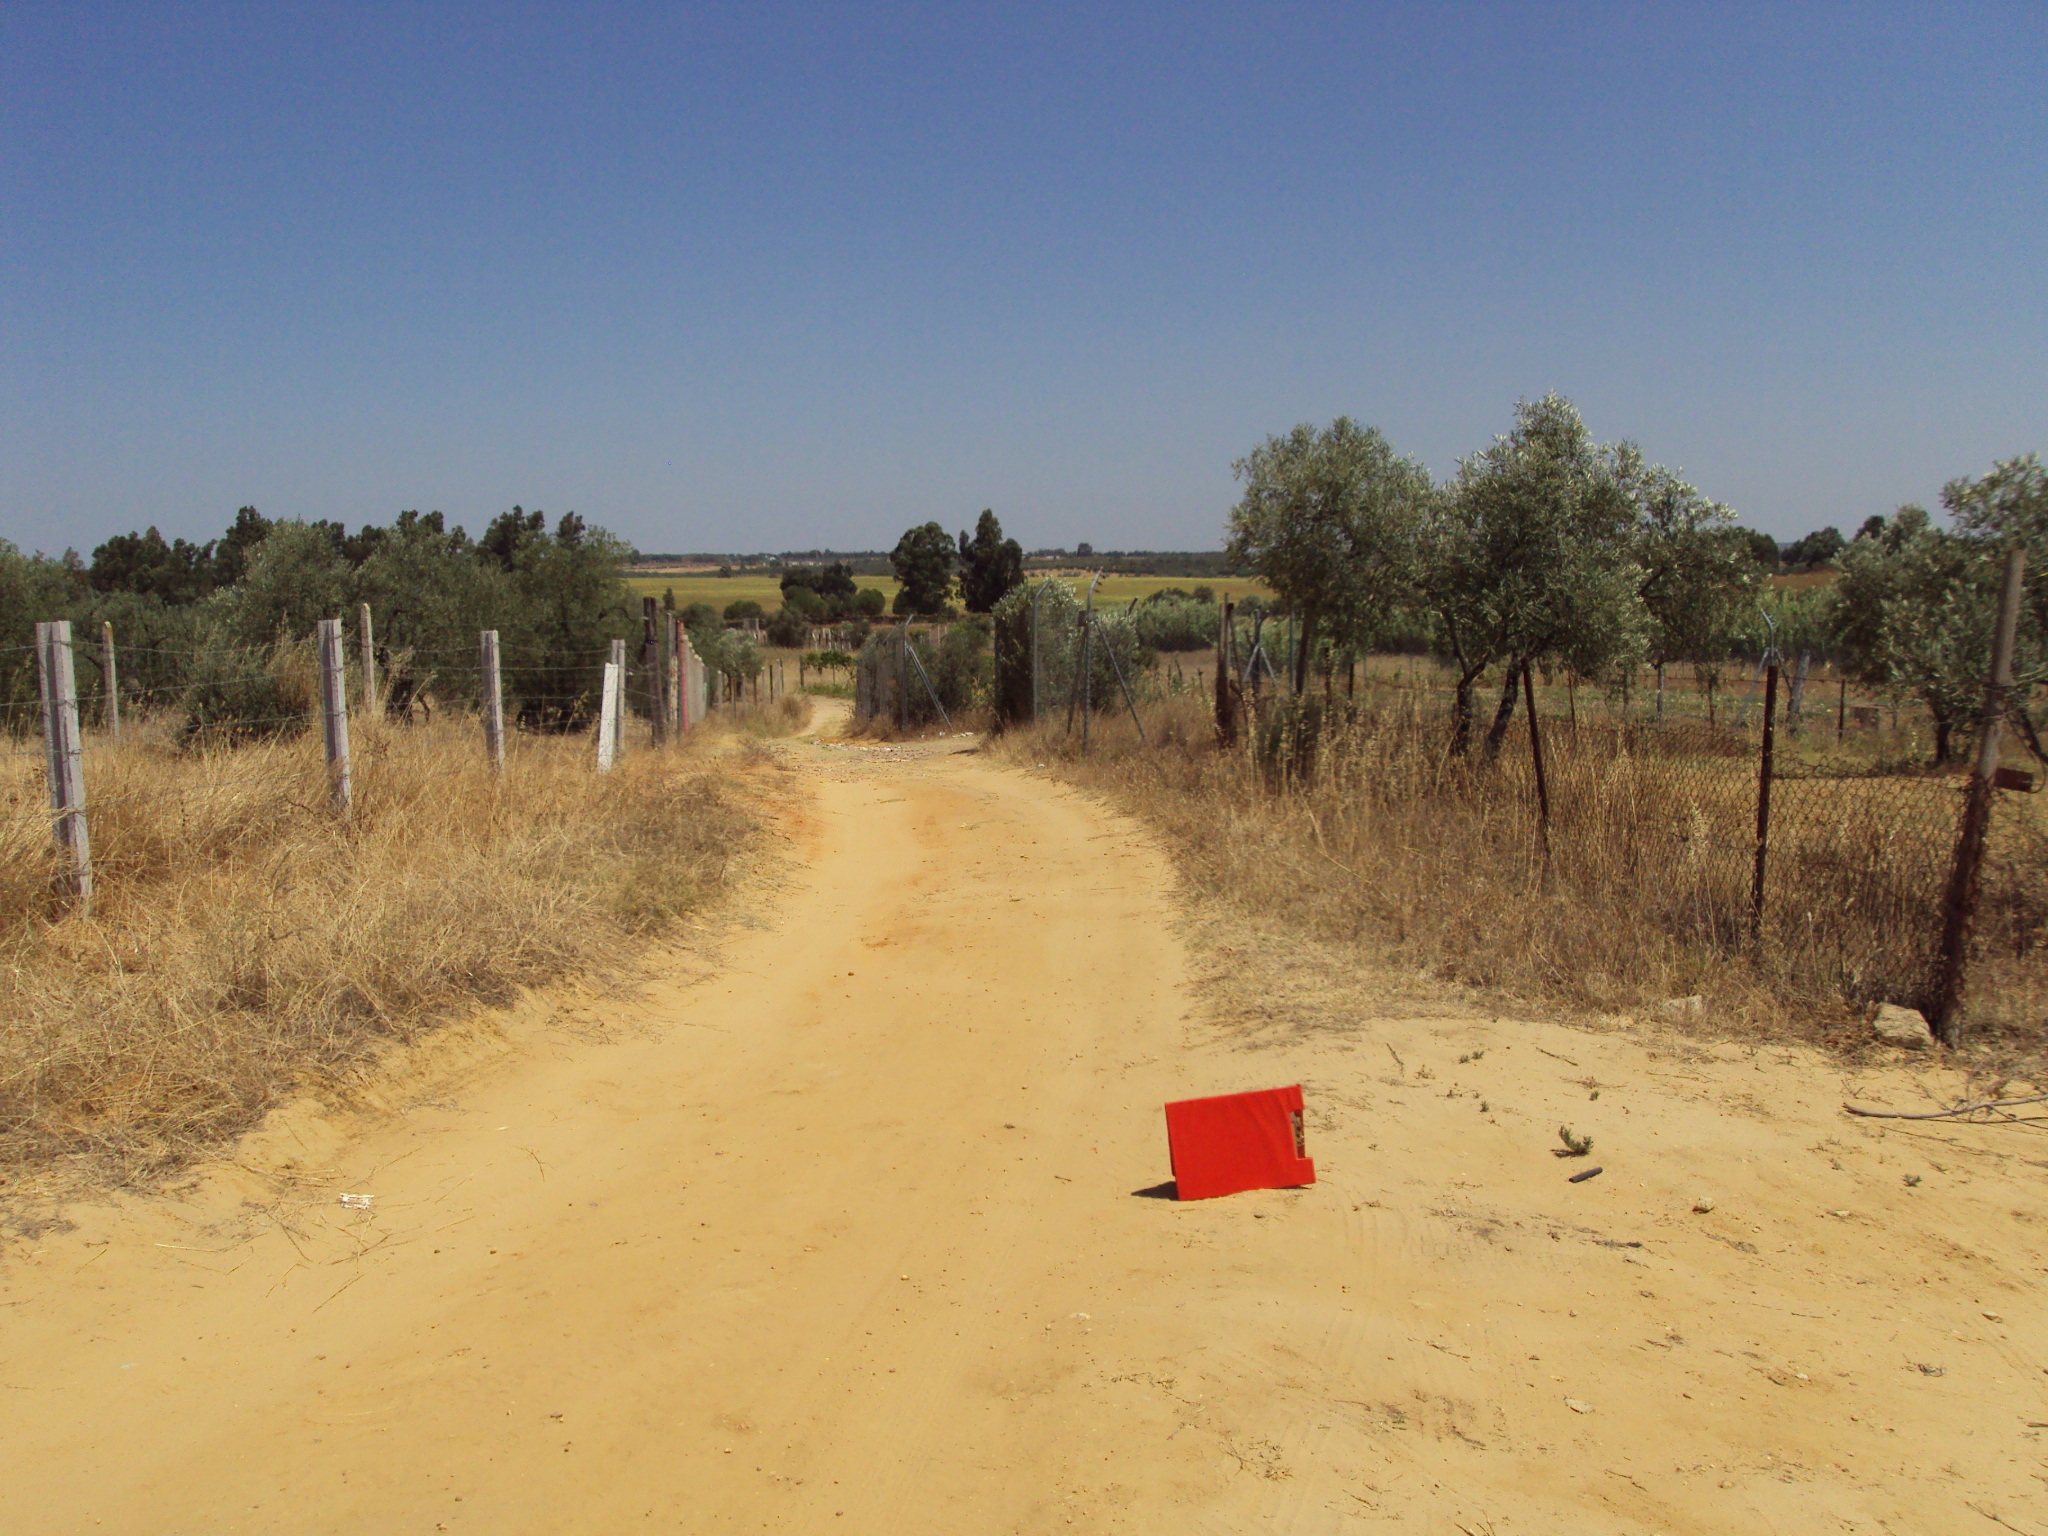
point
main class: Cropland
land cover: Other fresh vegetables
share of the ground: 10 - 25 %
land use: Agriculture (excluding fallow land and kitchen gardens)
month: July
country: ES
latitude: 37.2471
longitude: -6.5463
